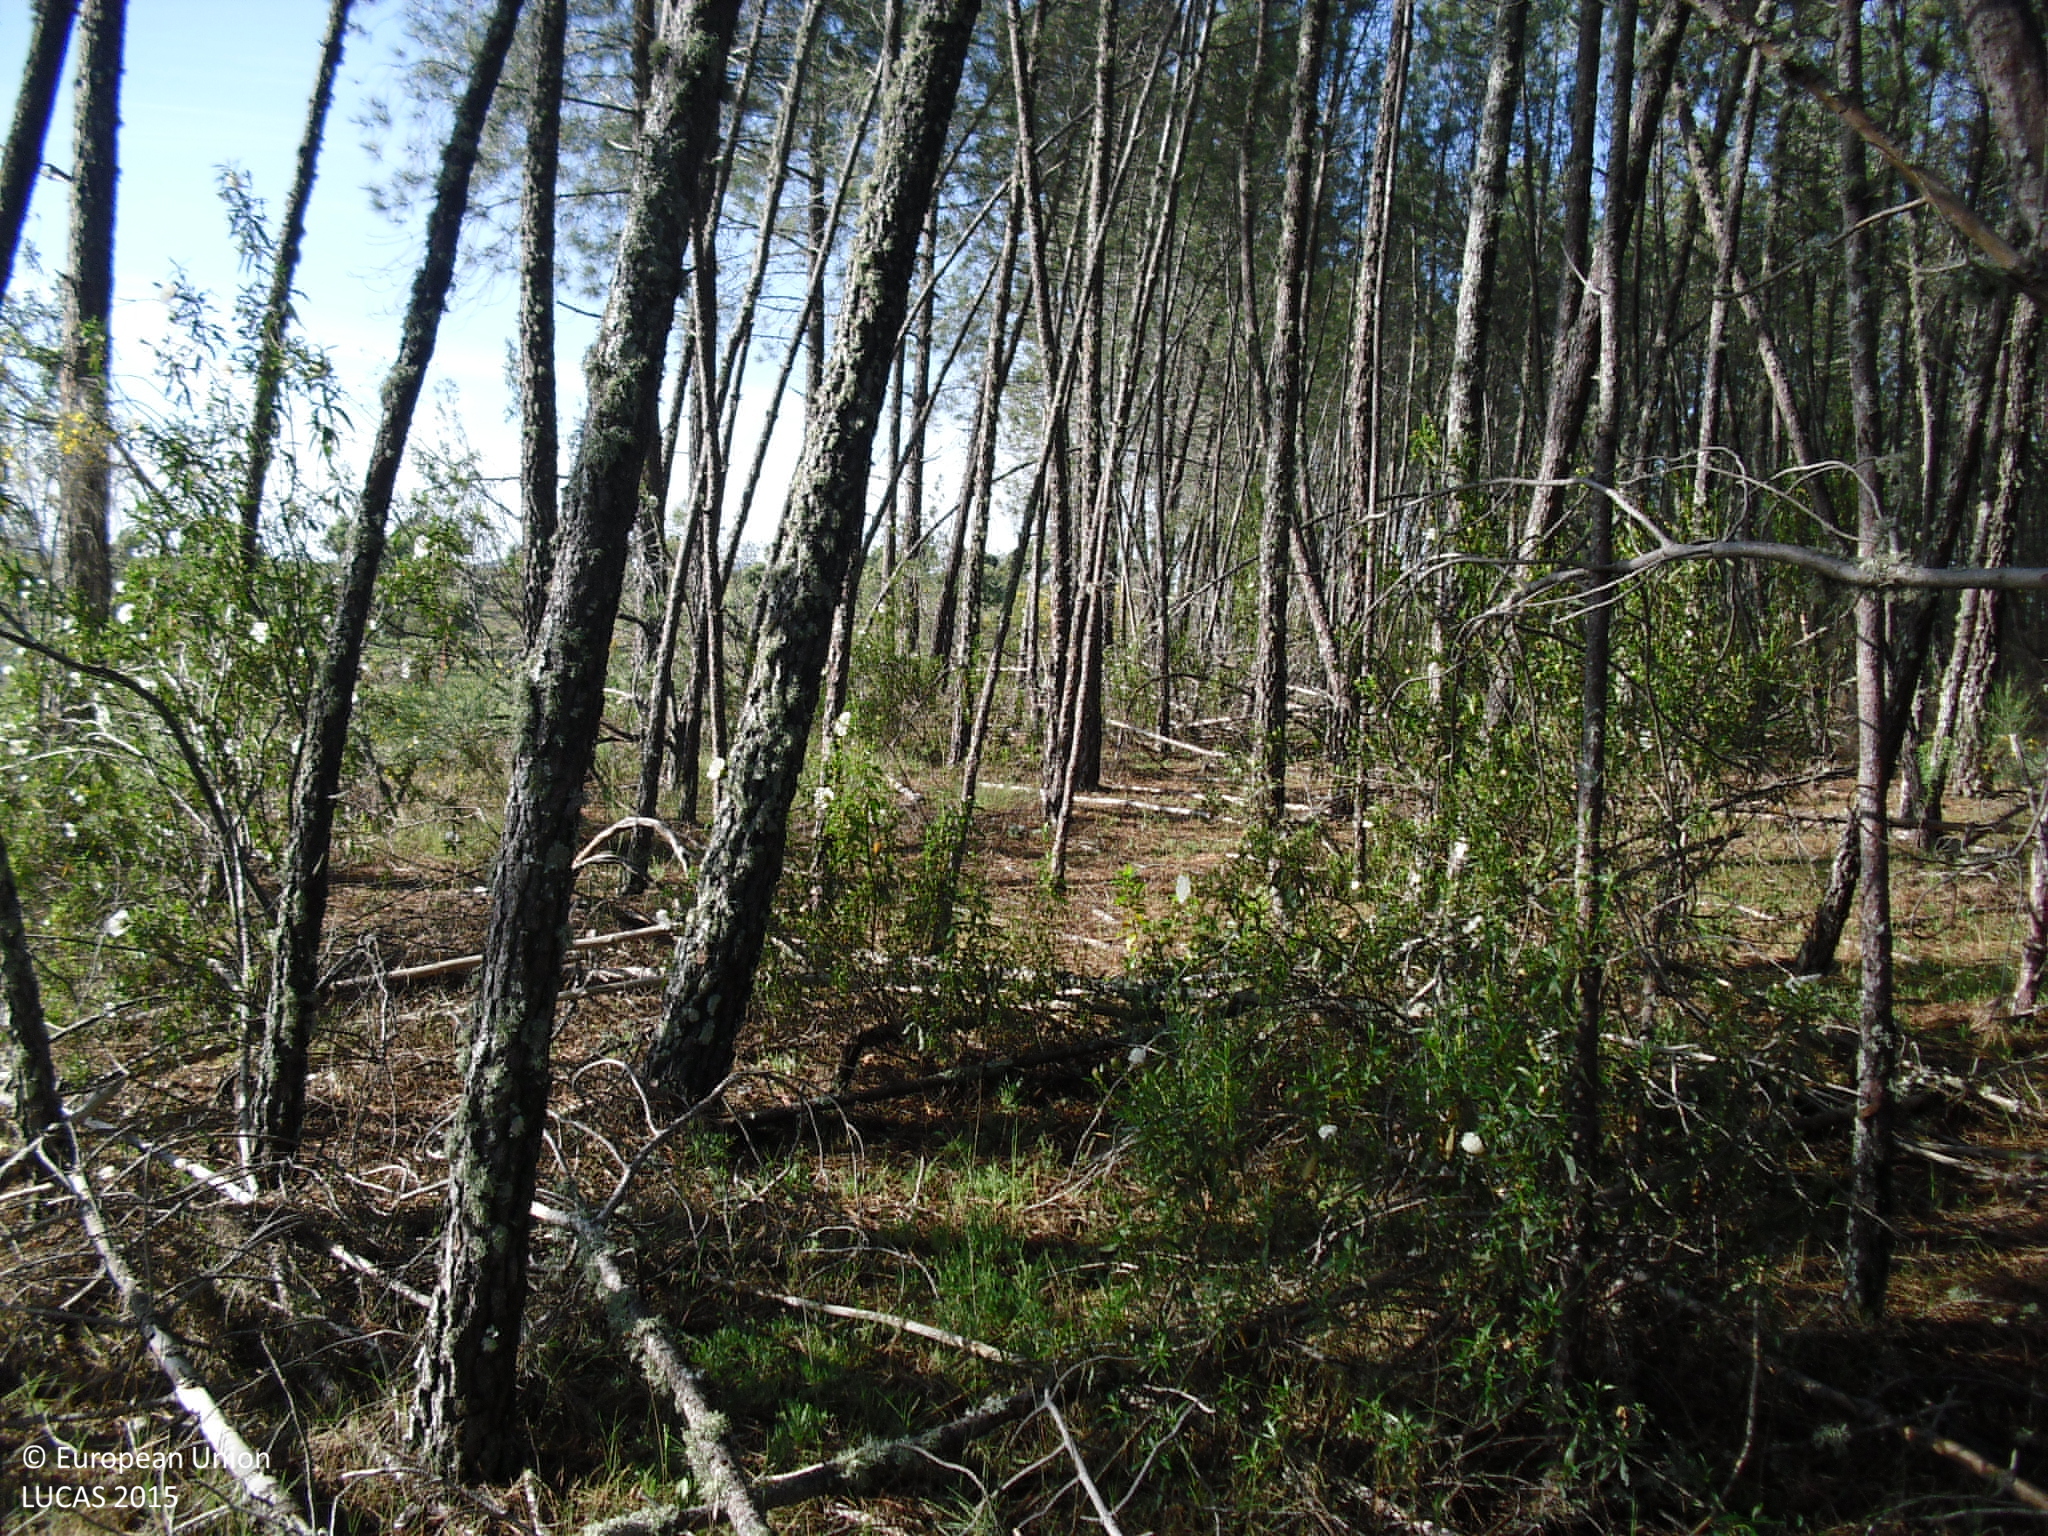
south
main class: Woodland
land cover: Pine dominated coniferous woodland
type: coniferous forest of the mediterranean region
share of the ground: > 75 %
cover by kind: coniferous forest trees 90 %, herbaceous plants 10 %
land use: Forestry
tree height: > 5 m
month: April
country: ES
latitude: 40.0574
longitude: -6.8161
